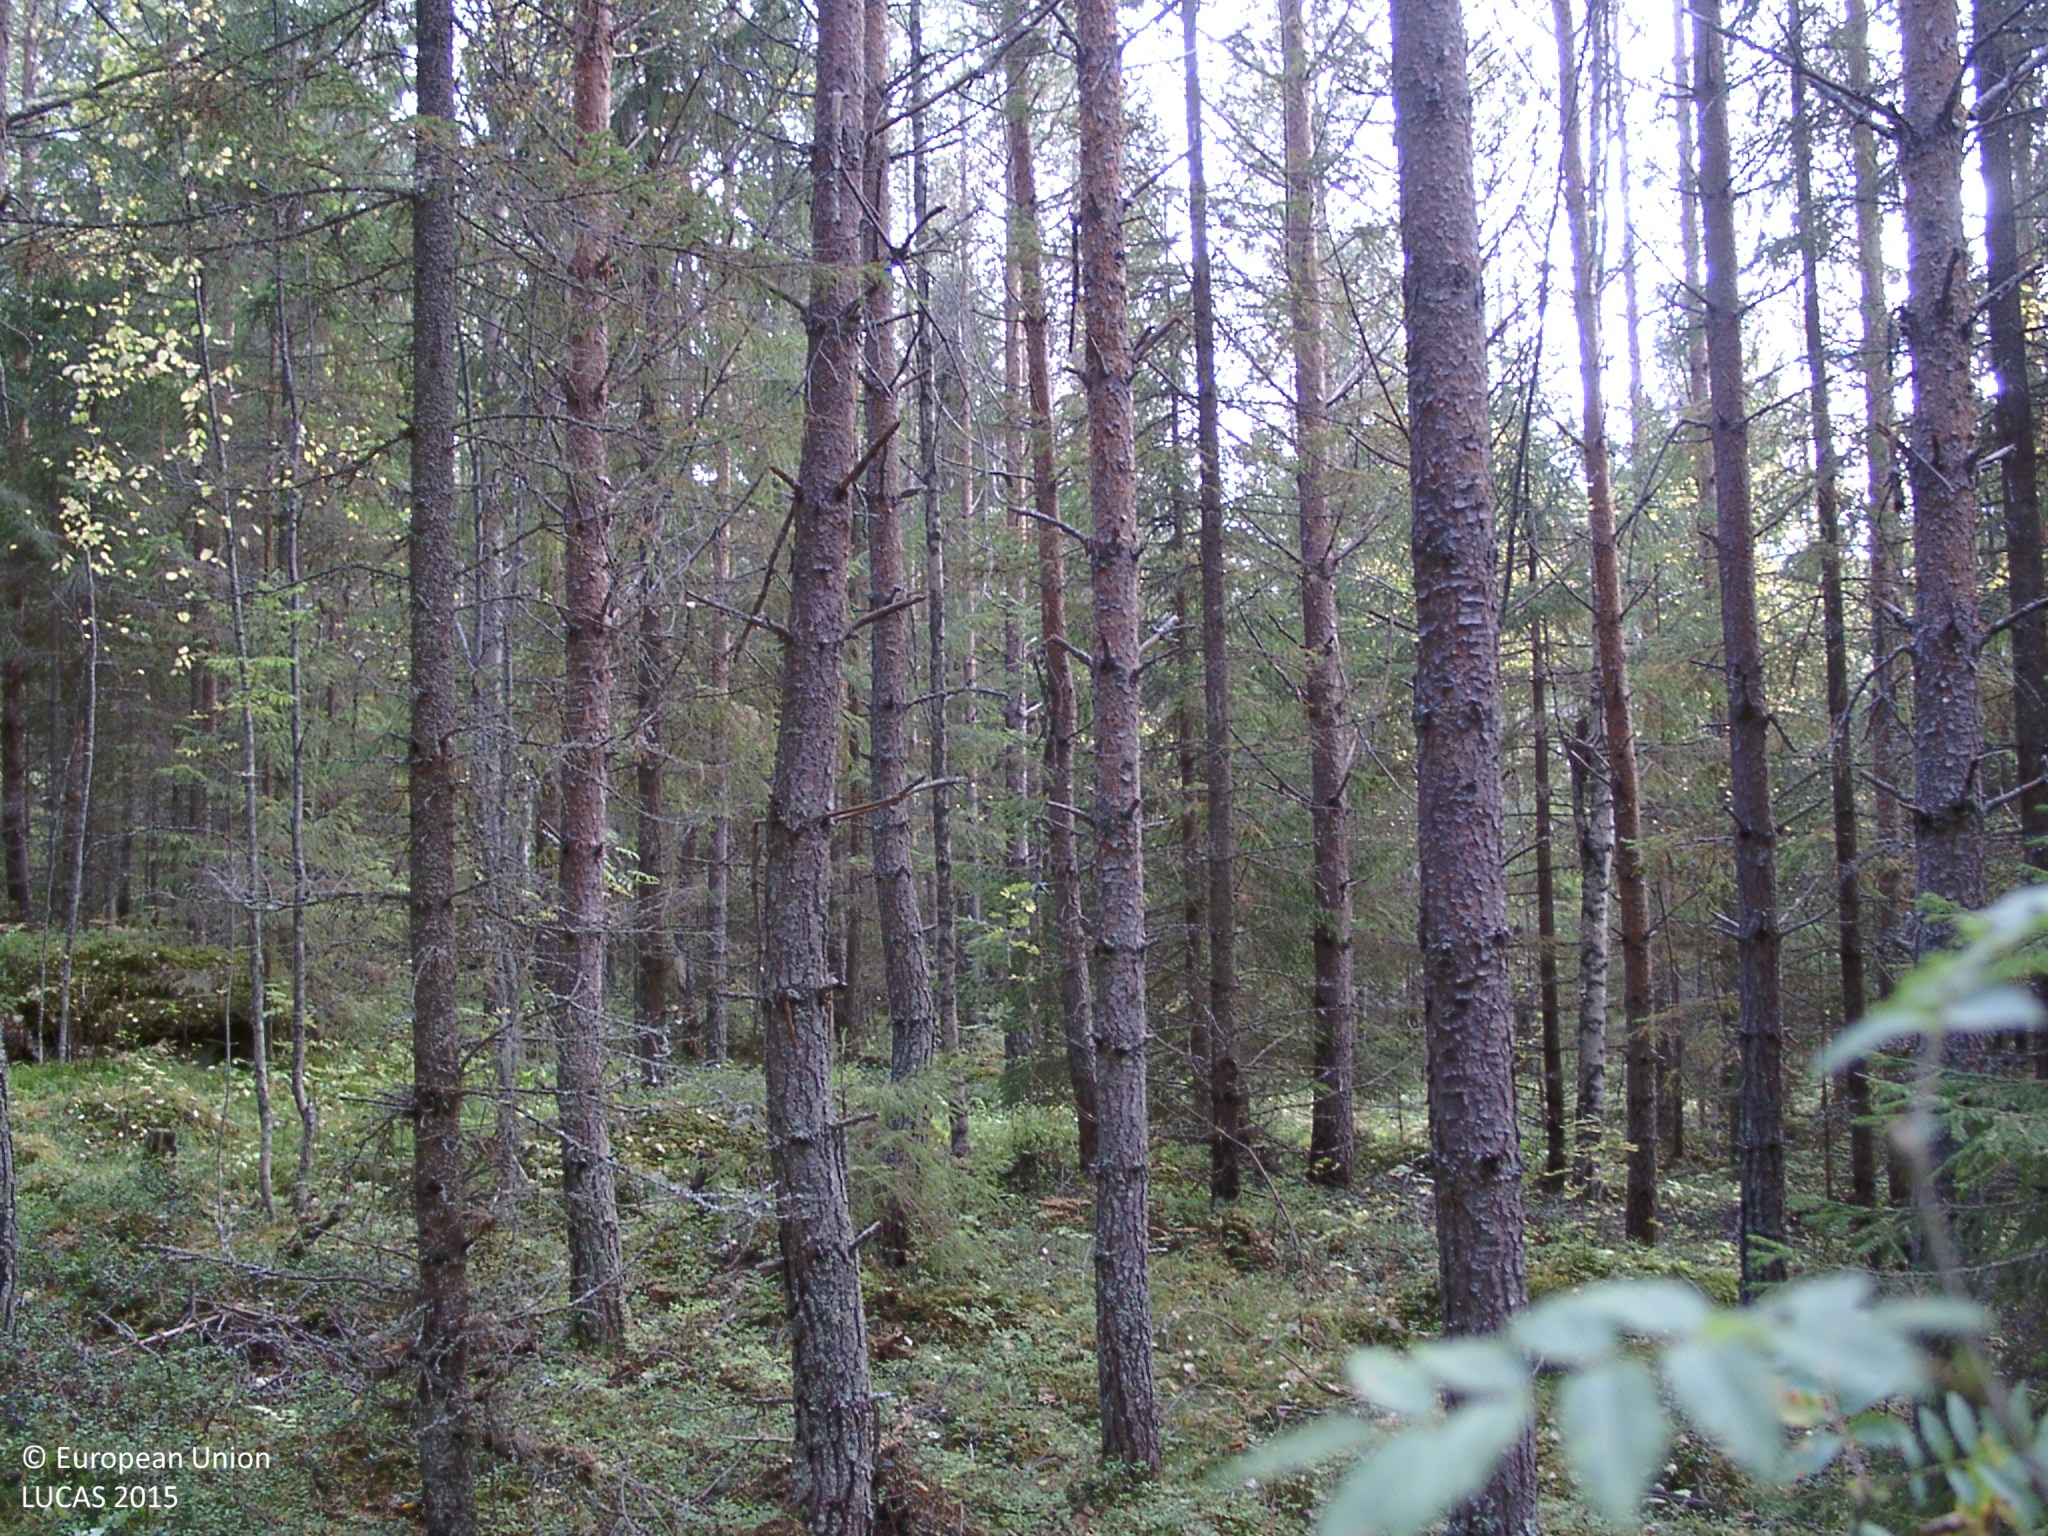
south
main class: Woodland
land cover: Other coniferous woodland
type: boreal forest
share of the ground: > 75 %
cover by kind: coniferous forest trees 80 %, shrubs 10 %, herbaceous plants 5 %, lichens and mosses 5 %
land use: Forestry
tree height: > 5 m
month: September
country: FI
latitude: 62.5611
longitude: 25.2987
